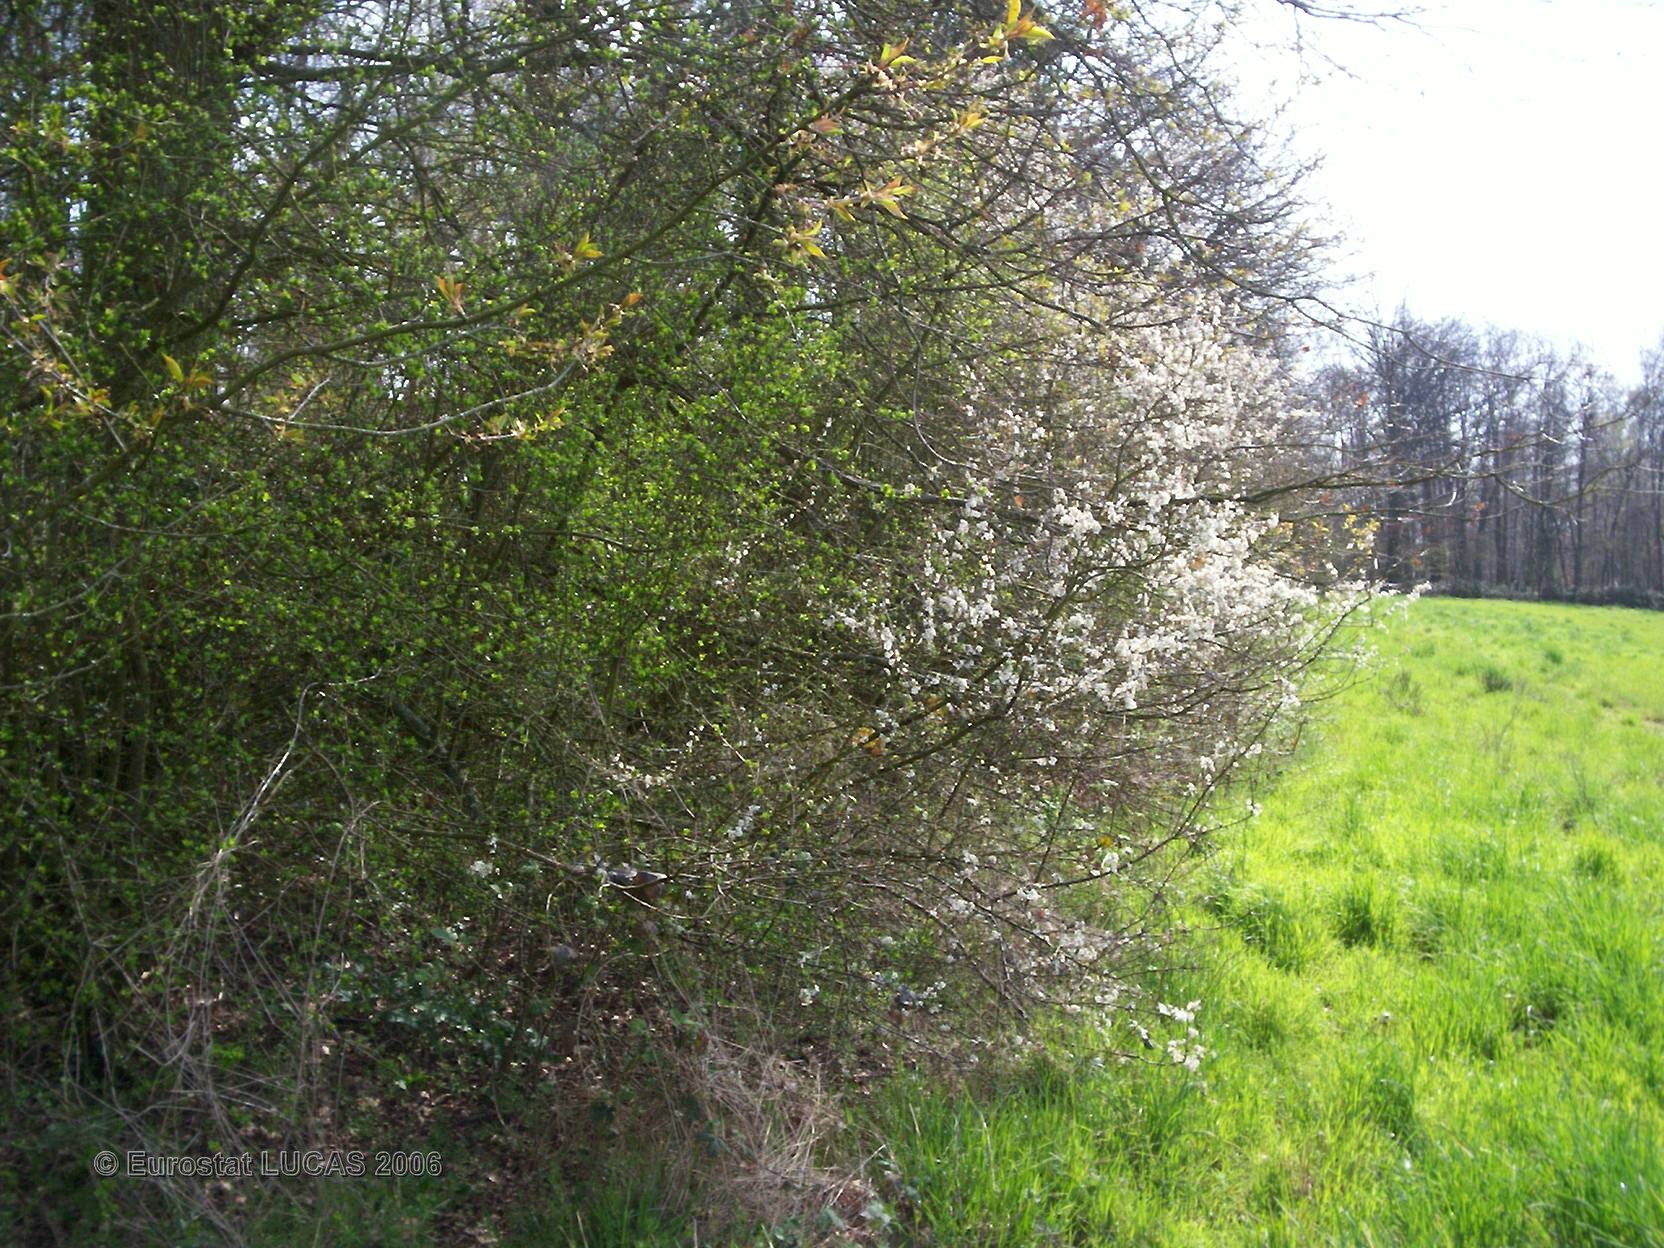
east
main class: Grassland
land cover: Grassland without tree/shrub cover
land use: Agriculture (excluding fallow land and kitchen gardens)
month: April
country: FR
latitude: 49.0174
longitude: 1.0499
